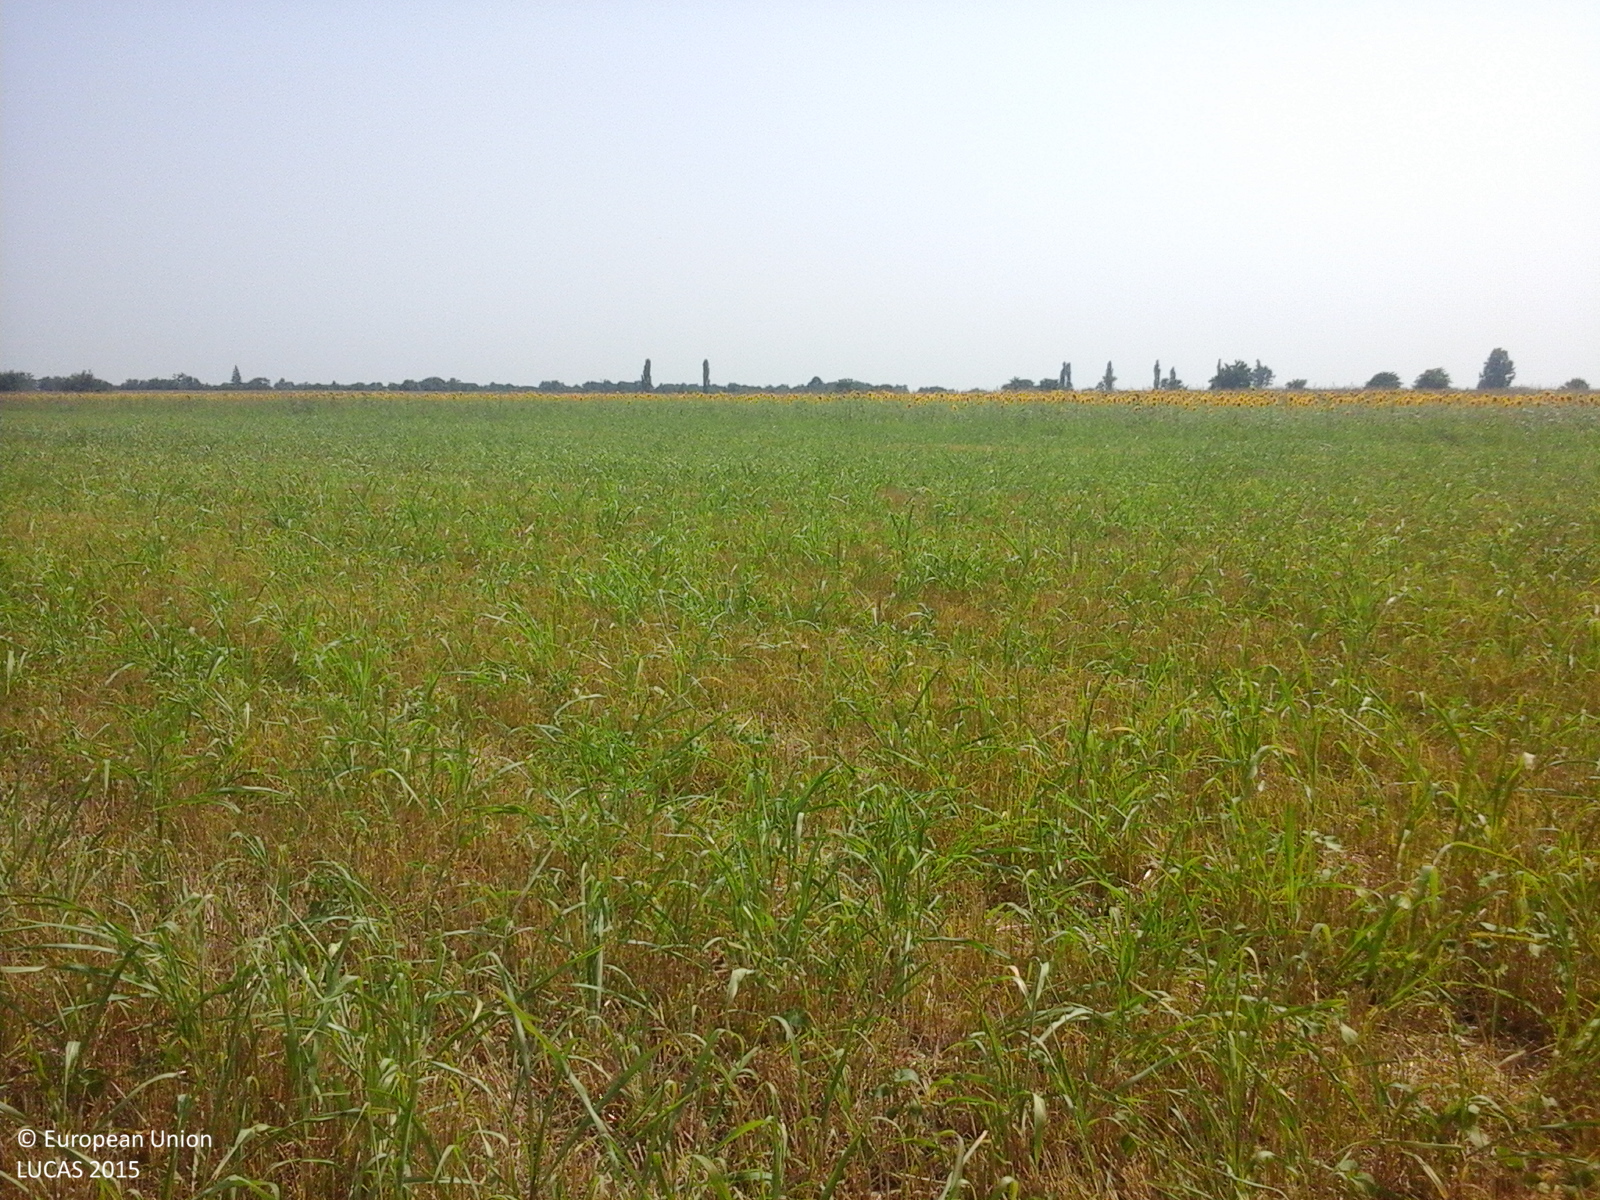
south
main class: Cropland
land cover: Barley
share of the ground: 25 - 50 %
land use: Agriculture (excluding fallow land and kitchen gardens)
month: July
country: RO
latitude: 44.8504
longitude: 26.7649
